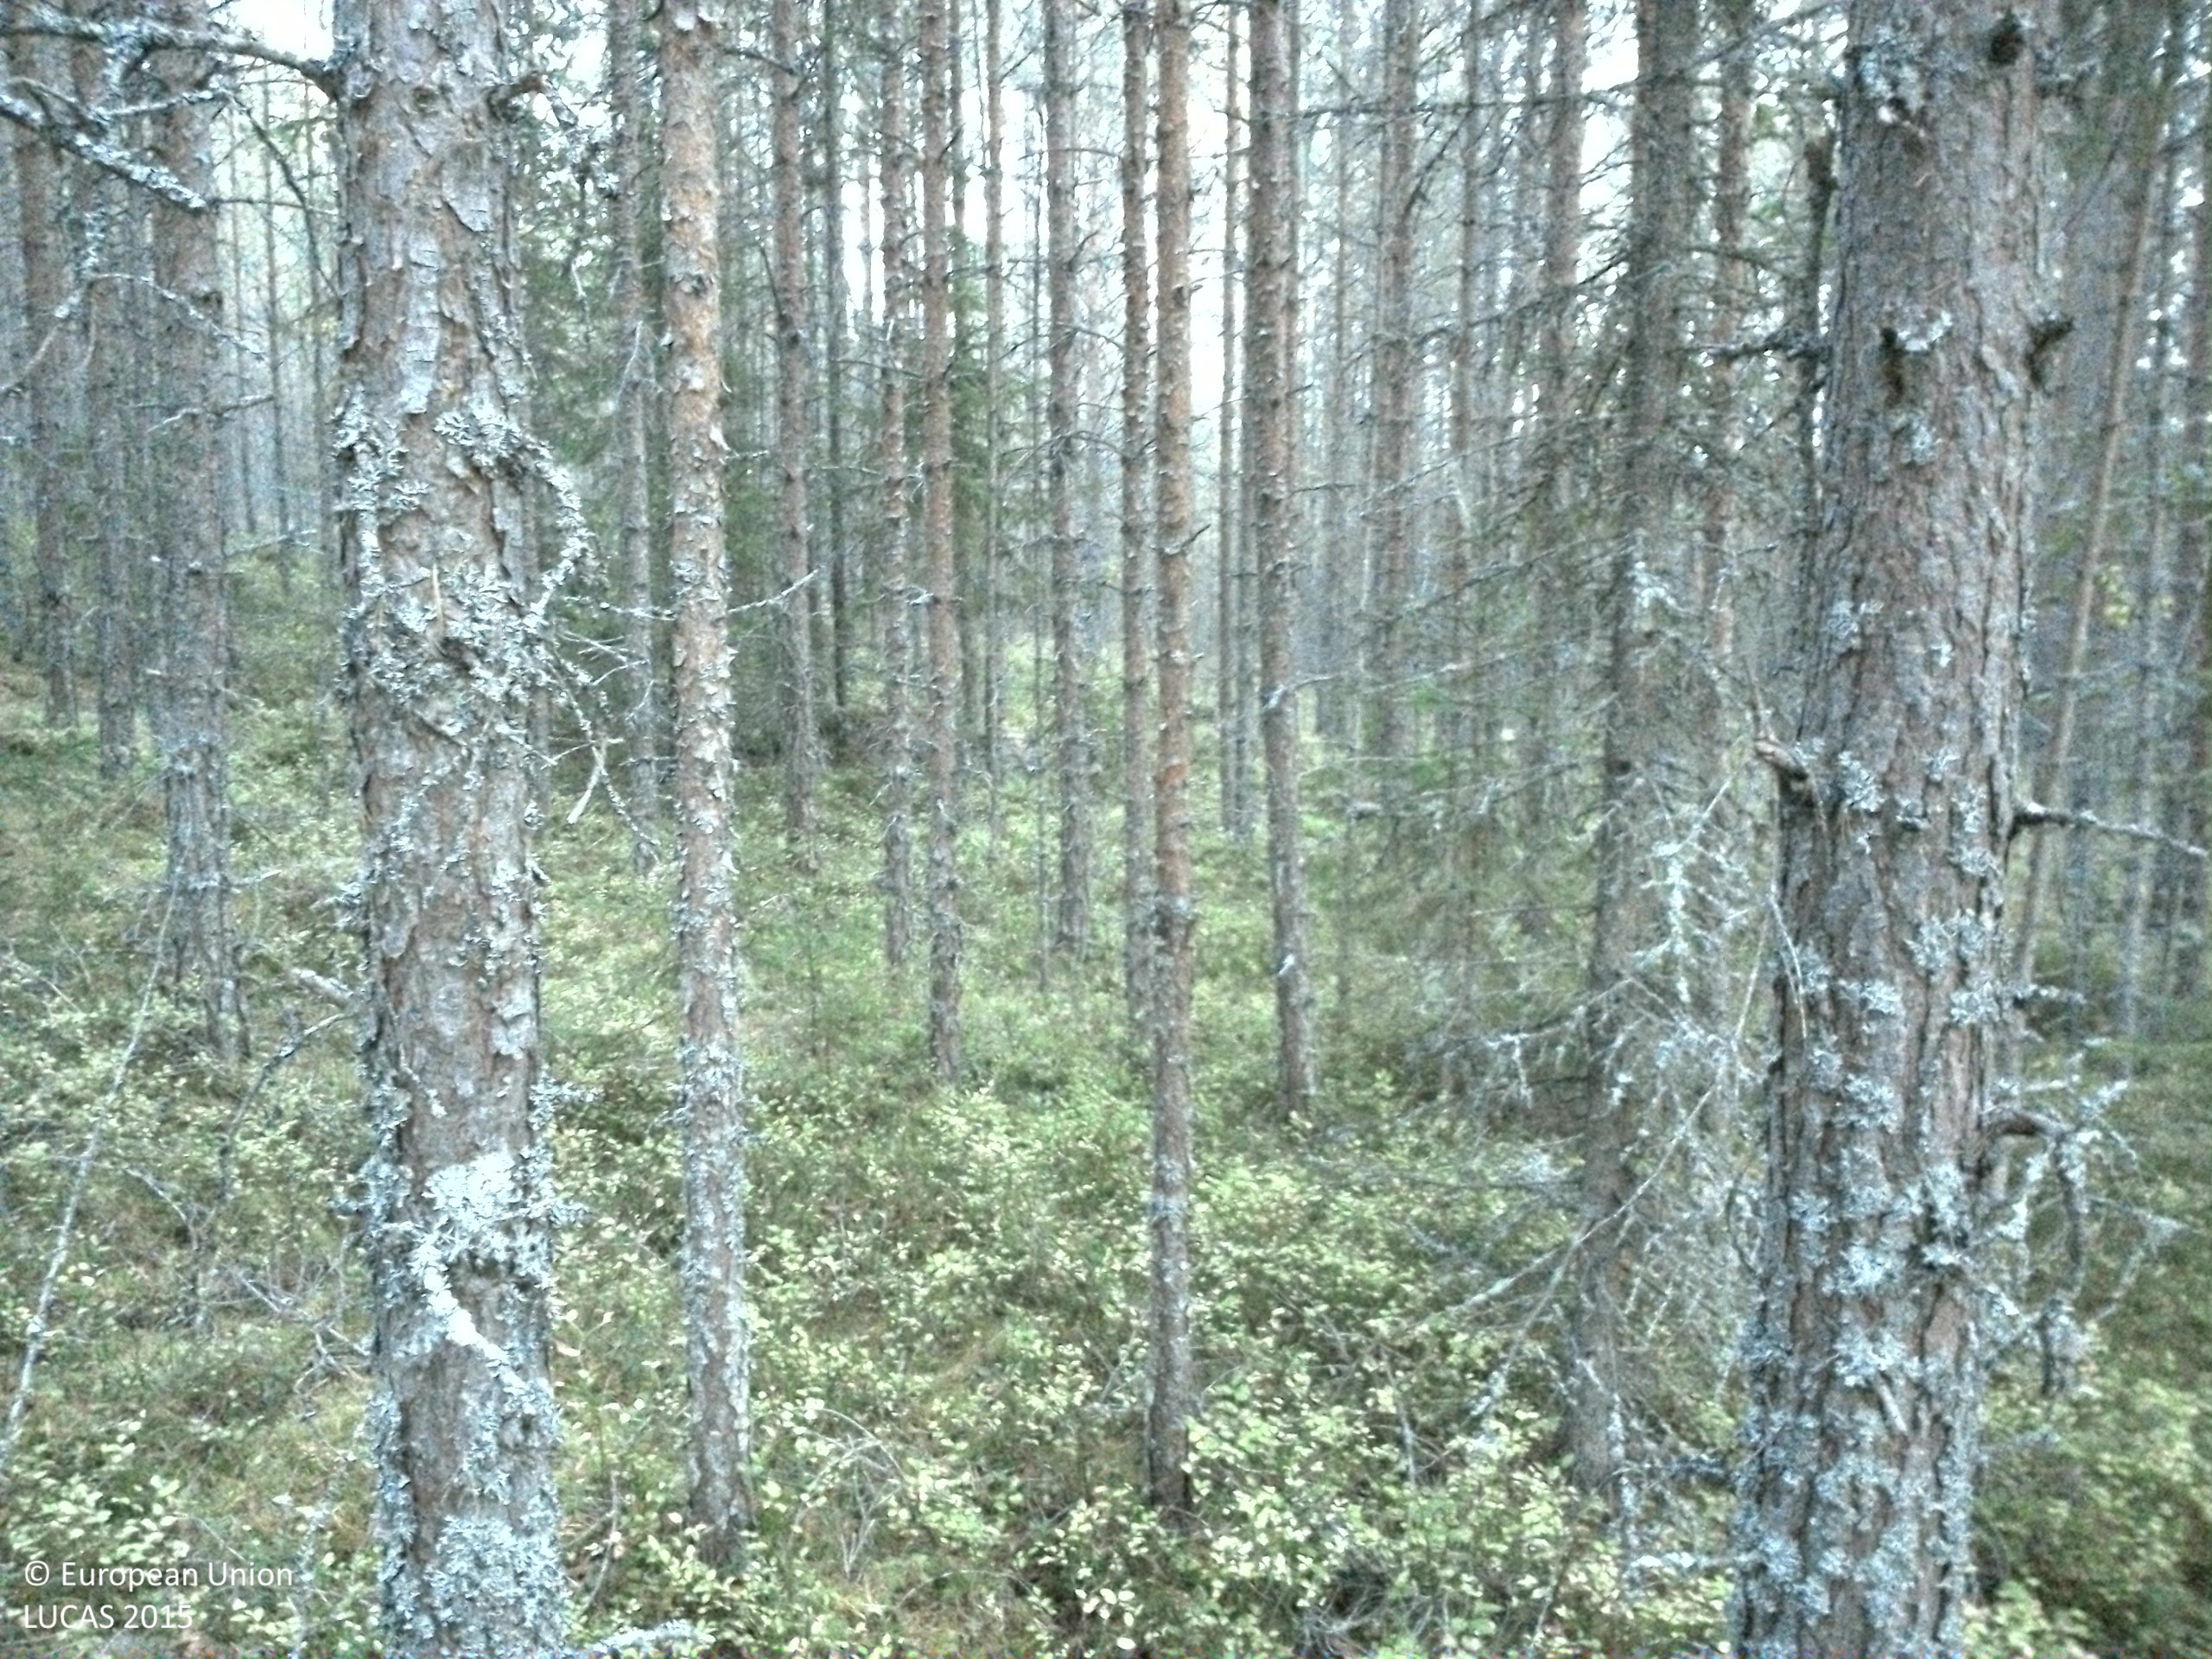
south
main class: Woodland
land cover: Pine dominated coniferous woodland
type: boreal forest
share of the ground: > 75 %
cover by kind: coniferous forest trees 75 %, shrubs 25 %
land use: Forestry
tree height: > 5 m
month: October
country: SE
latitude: 61.2086
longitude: 15.0667
